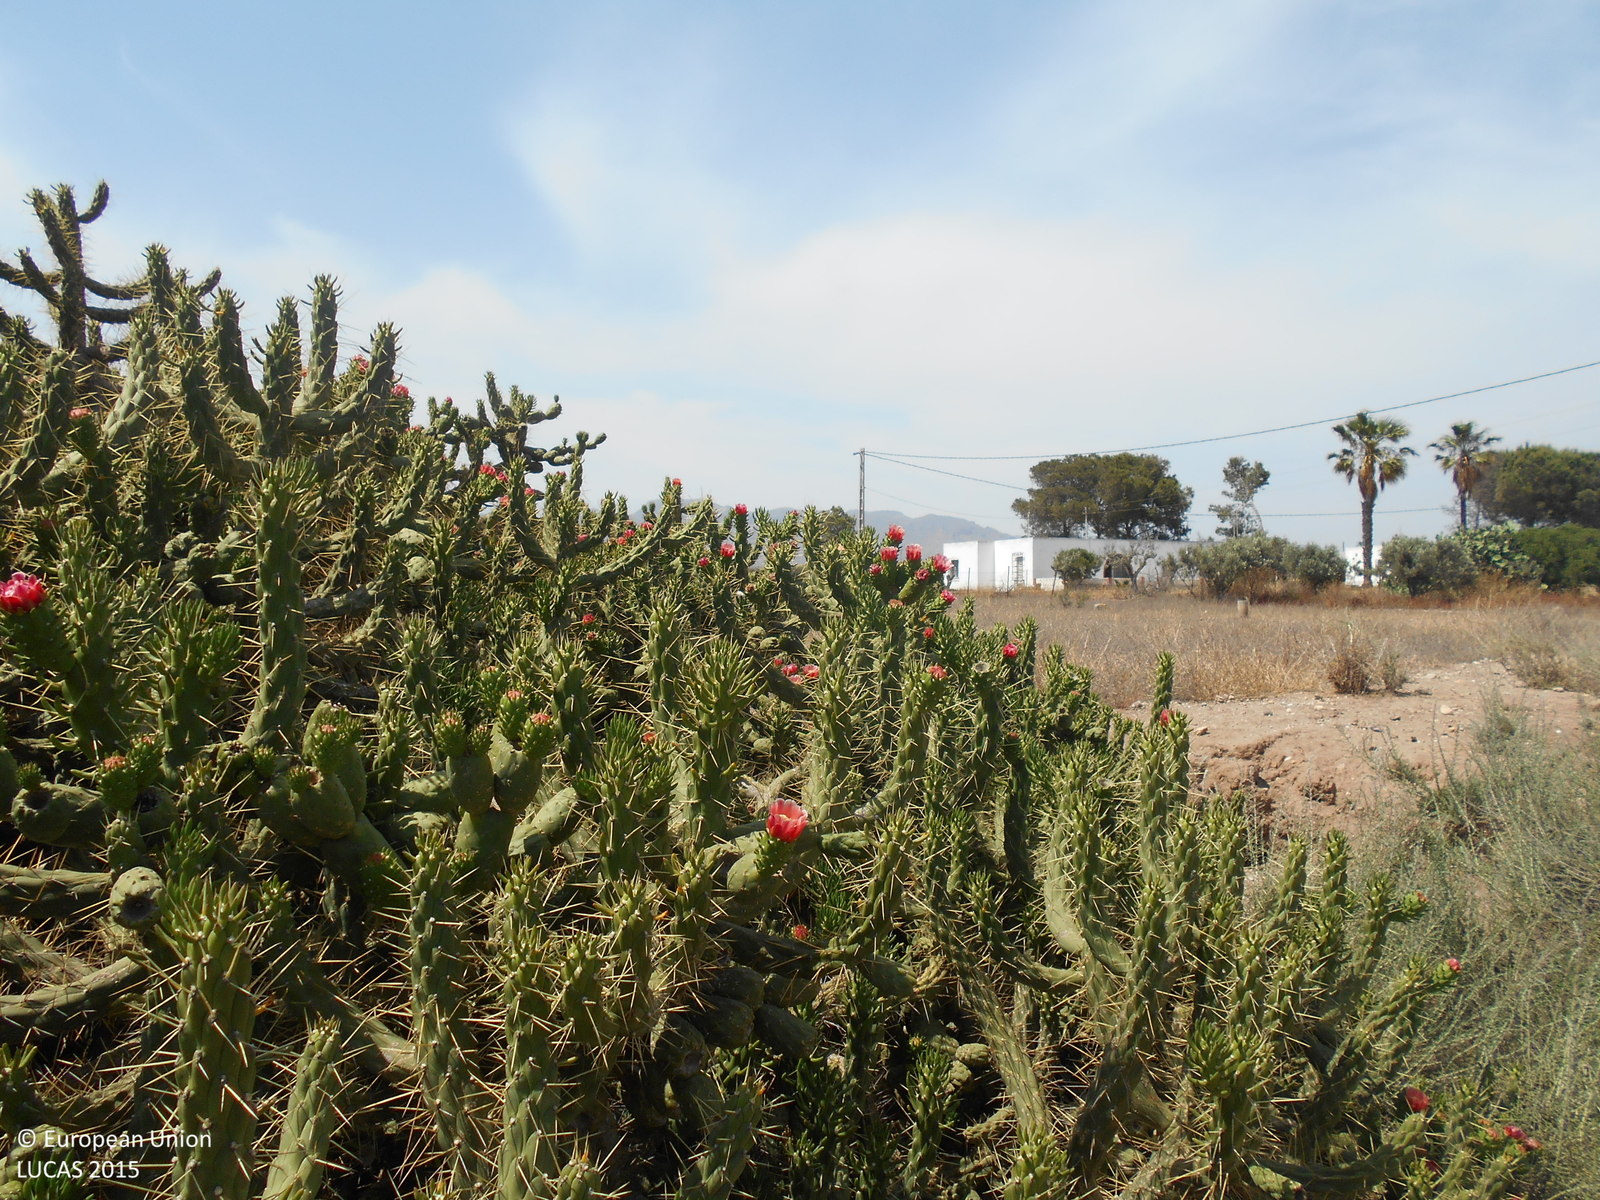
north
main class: Shrubland
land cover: Shrubland without tree cover
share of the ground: 10 - 25 %
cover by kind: herbaceous plants 40 %, unconsolidated bare surface 40 %, shrubs 20 %
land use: Semi-natural and natural areas not in use
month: May
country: ES
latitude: 36.8835
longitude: -2.2153
